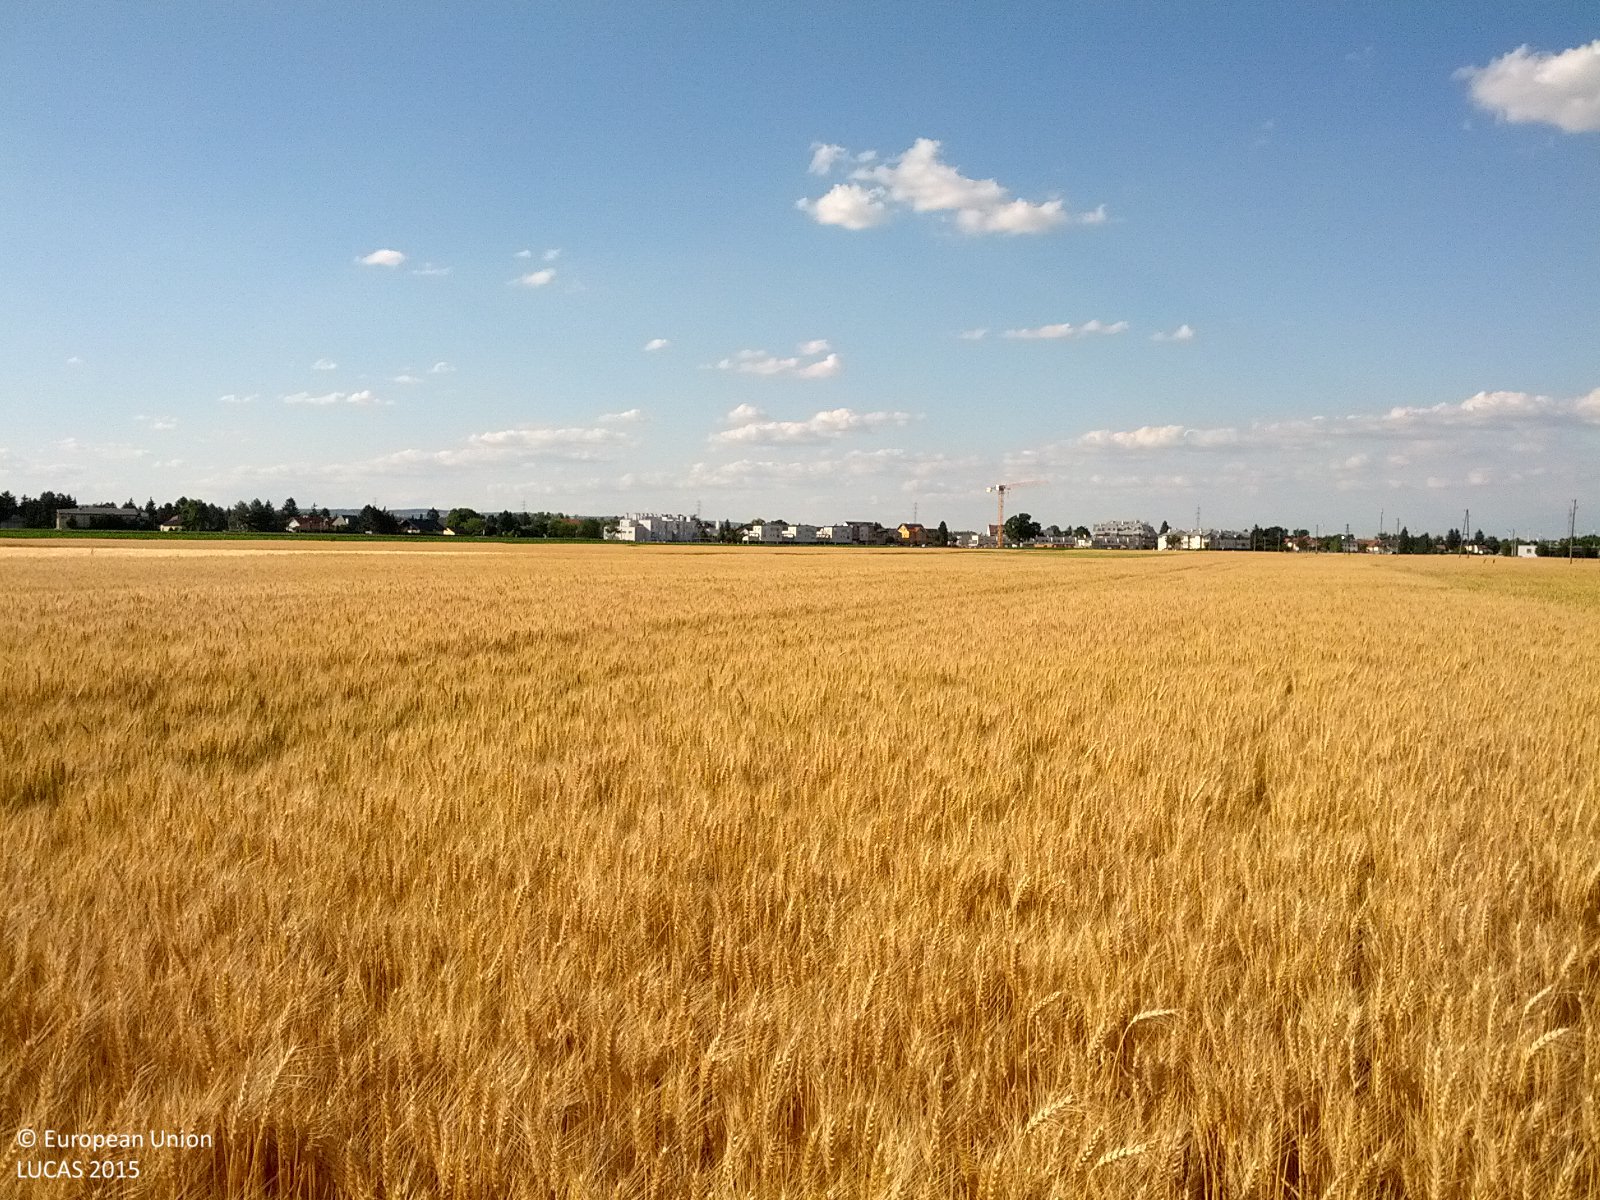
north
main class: Cropland
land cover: Common wheat
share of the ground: > 75 %
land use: Agriculture (excluding fallow land and kitchen gardens)
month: June
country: AT
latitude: 48.2867
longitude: 16.4611
